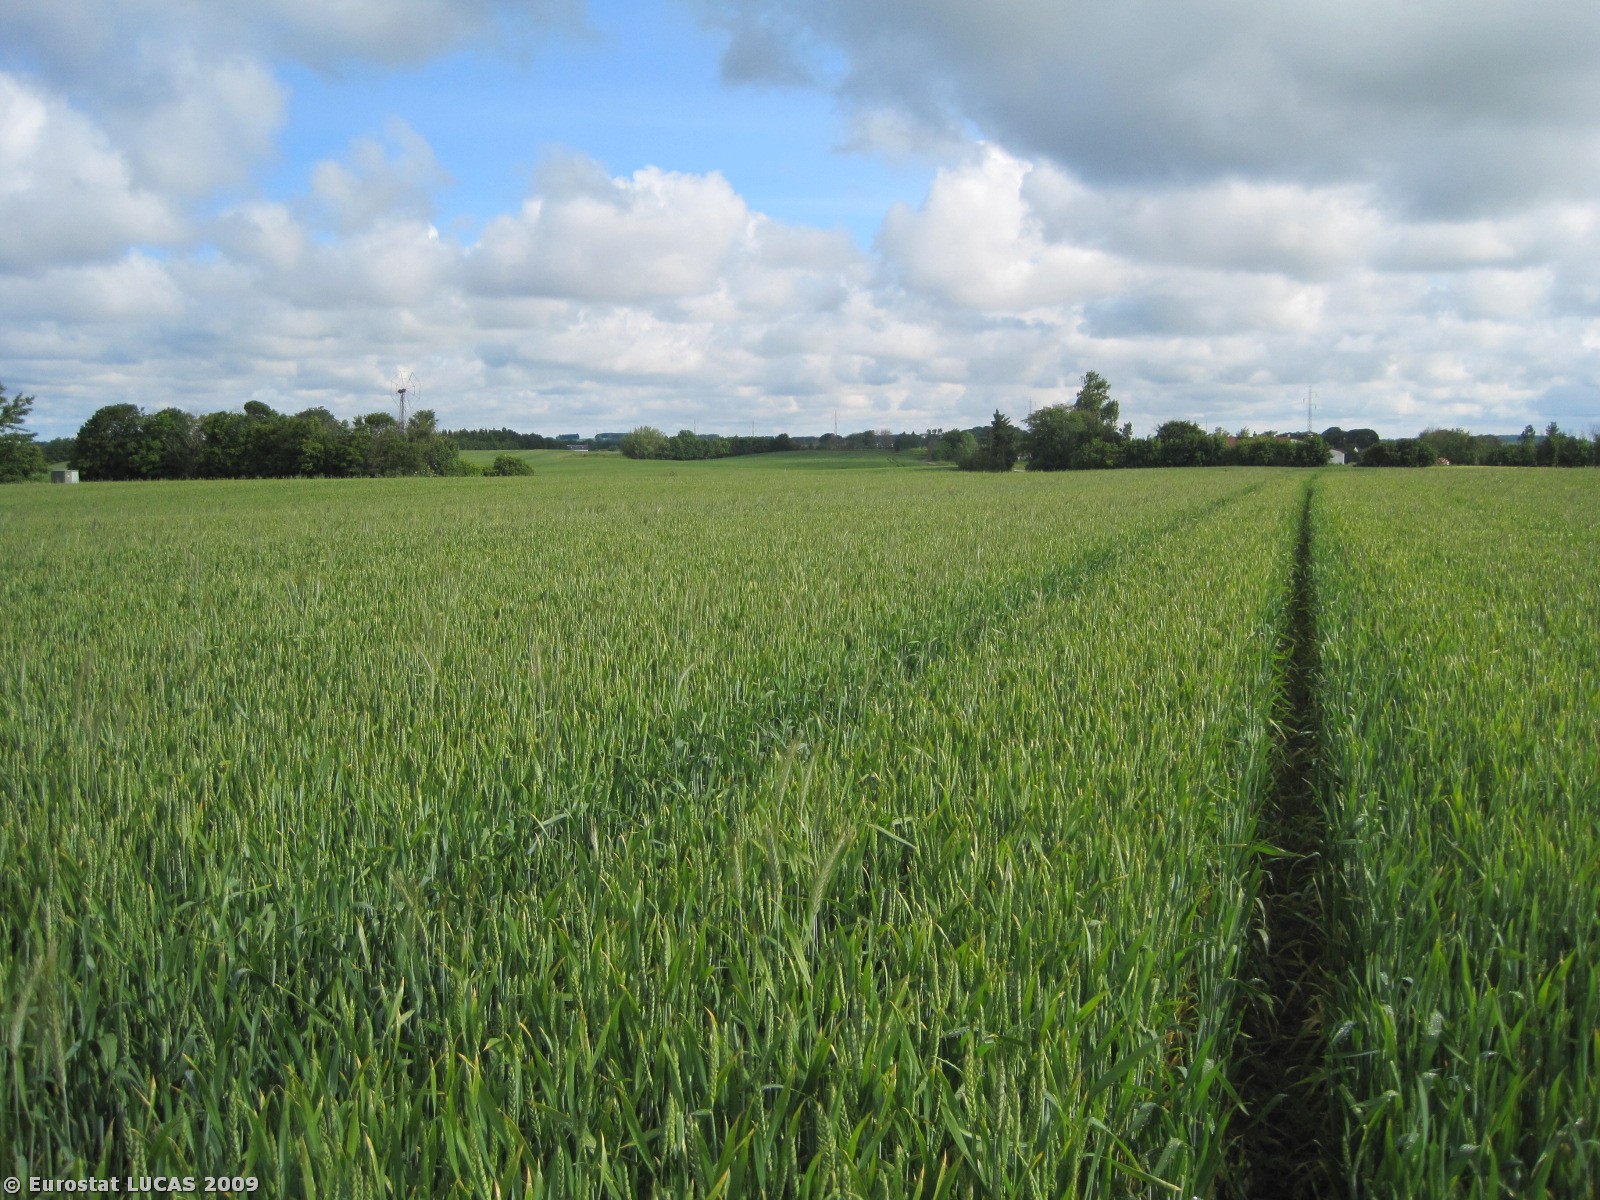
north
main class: Cropland
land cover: Common wheat
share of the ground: > 75 %
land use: Agriculture (excluding fallow land and kitchen gardens)
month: June
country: DK
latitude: 57.3203
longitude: 10.0497
